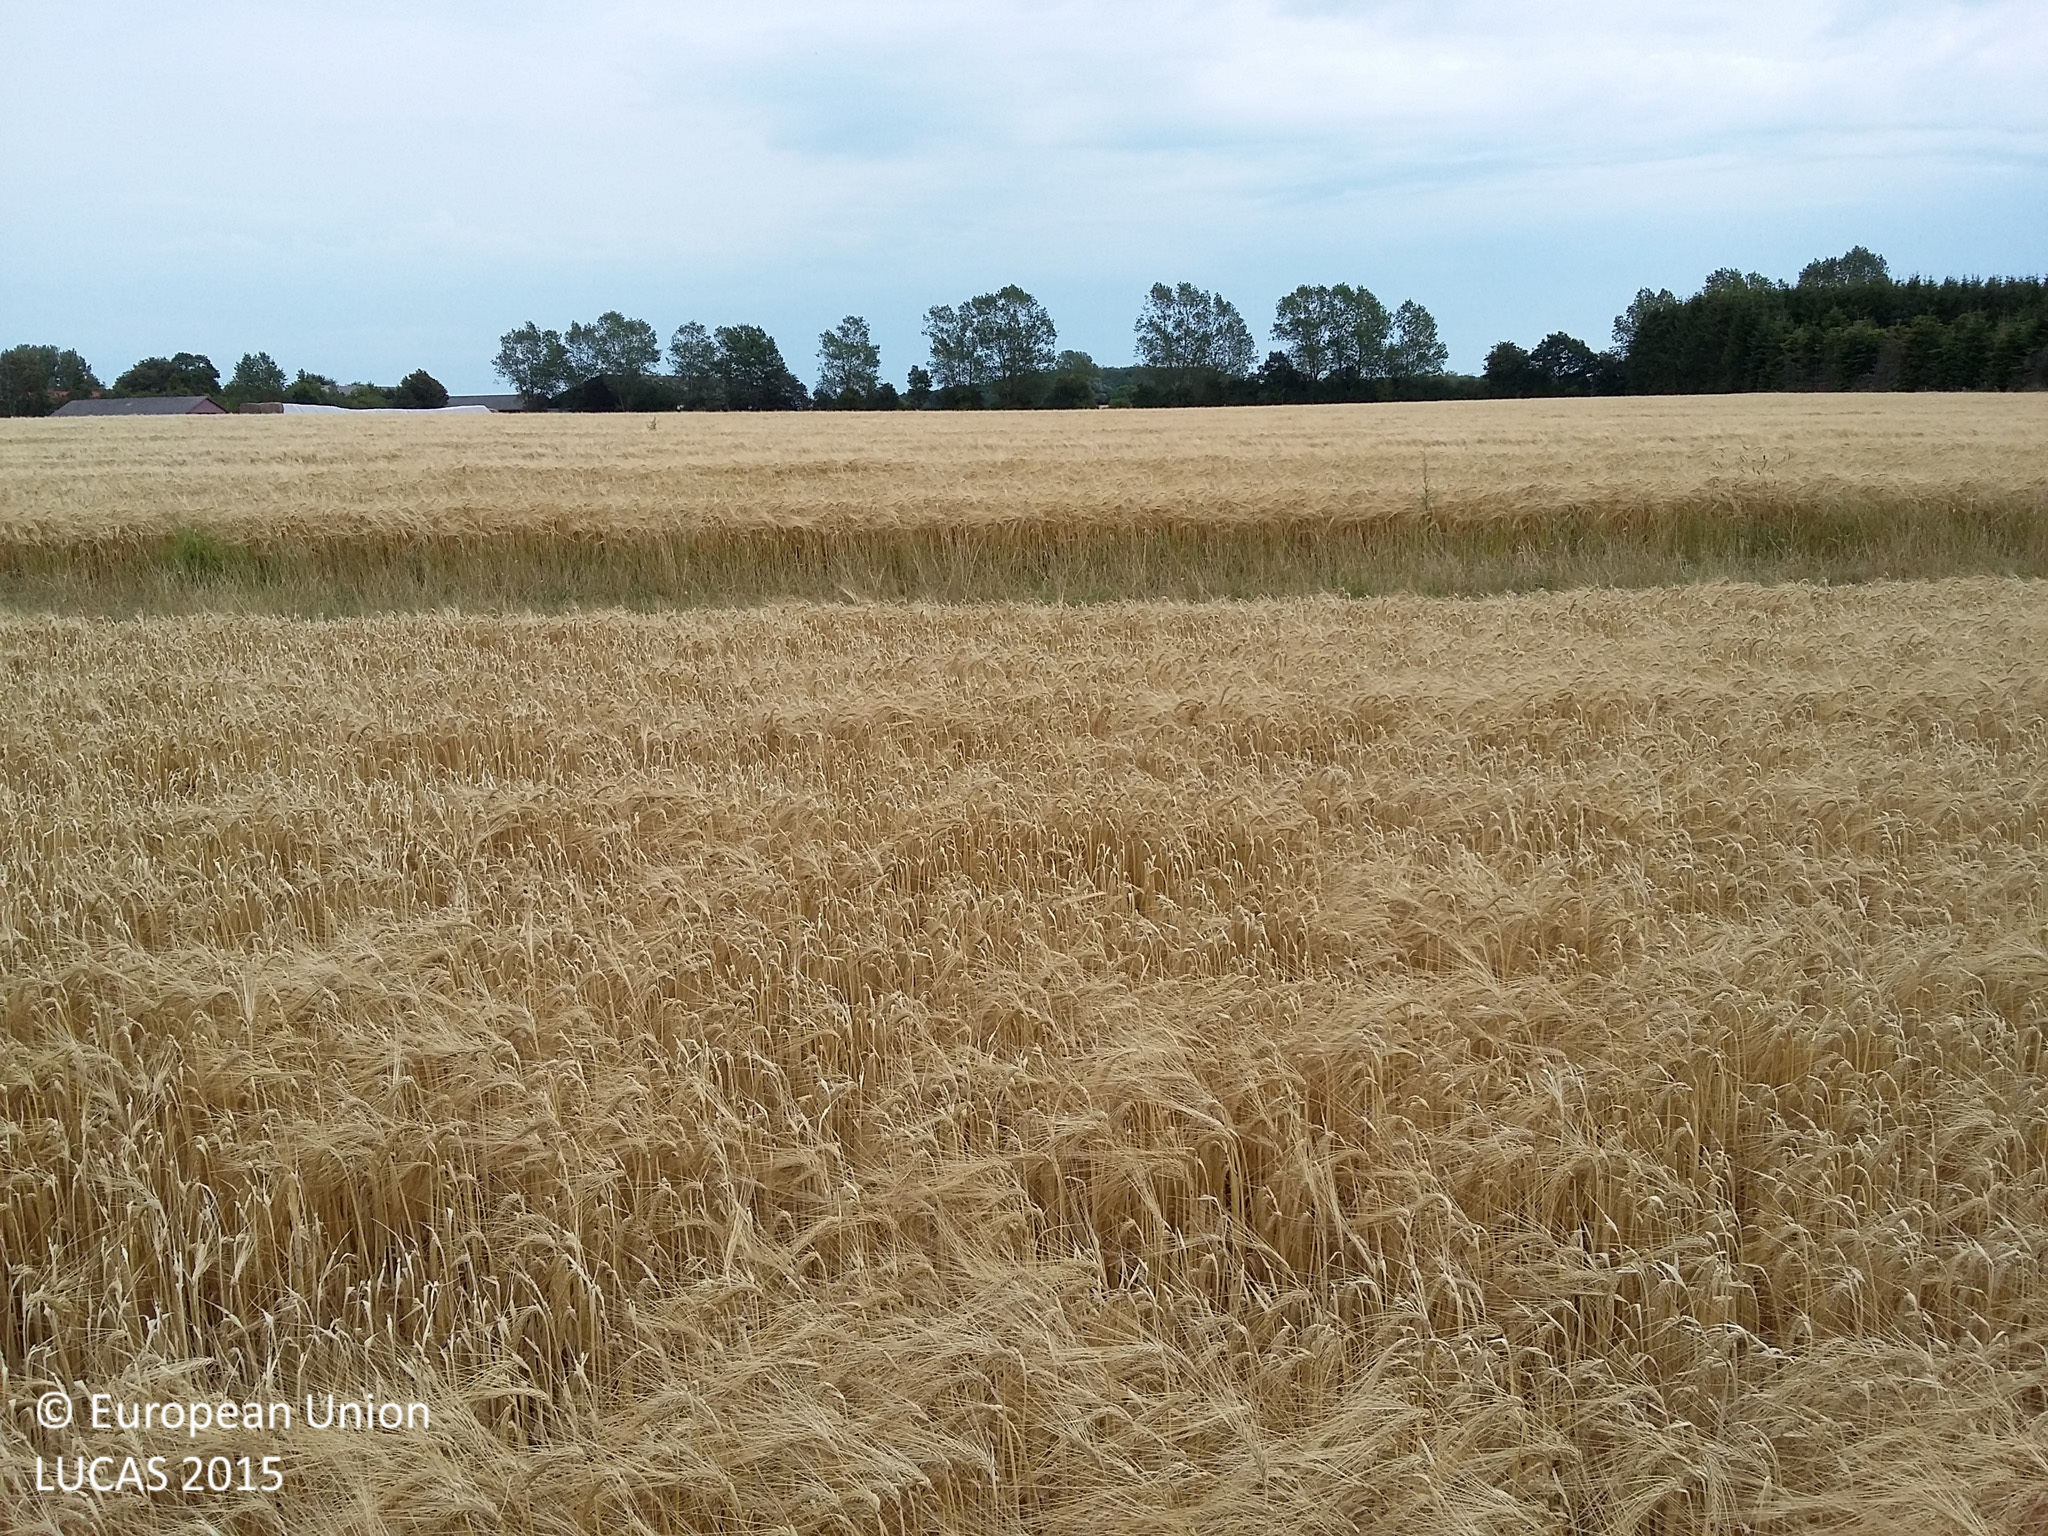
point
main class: Cropland
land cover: Barley
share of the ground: > 75 %
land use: Agriculture (excluding fallow land and kitchen gardens)
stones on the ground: < 10 %
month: August
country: DK
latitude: 55.3430
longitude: 12.1271
